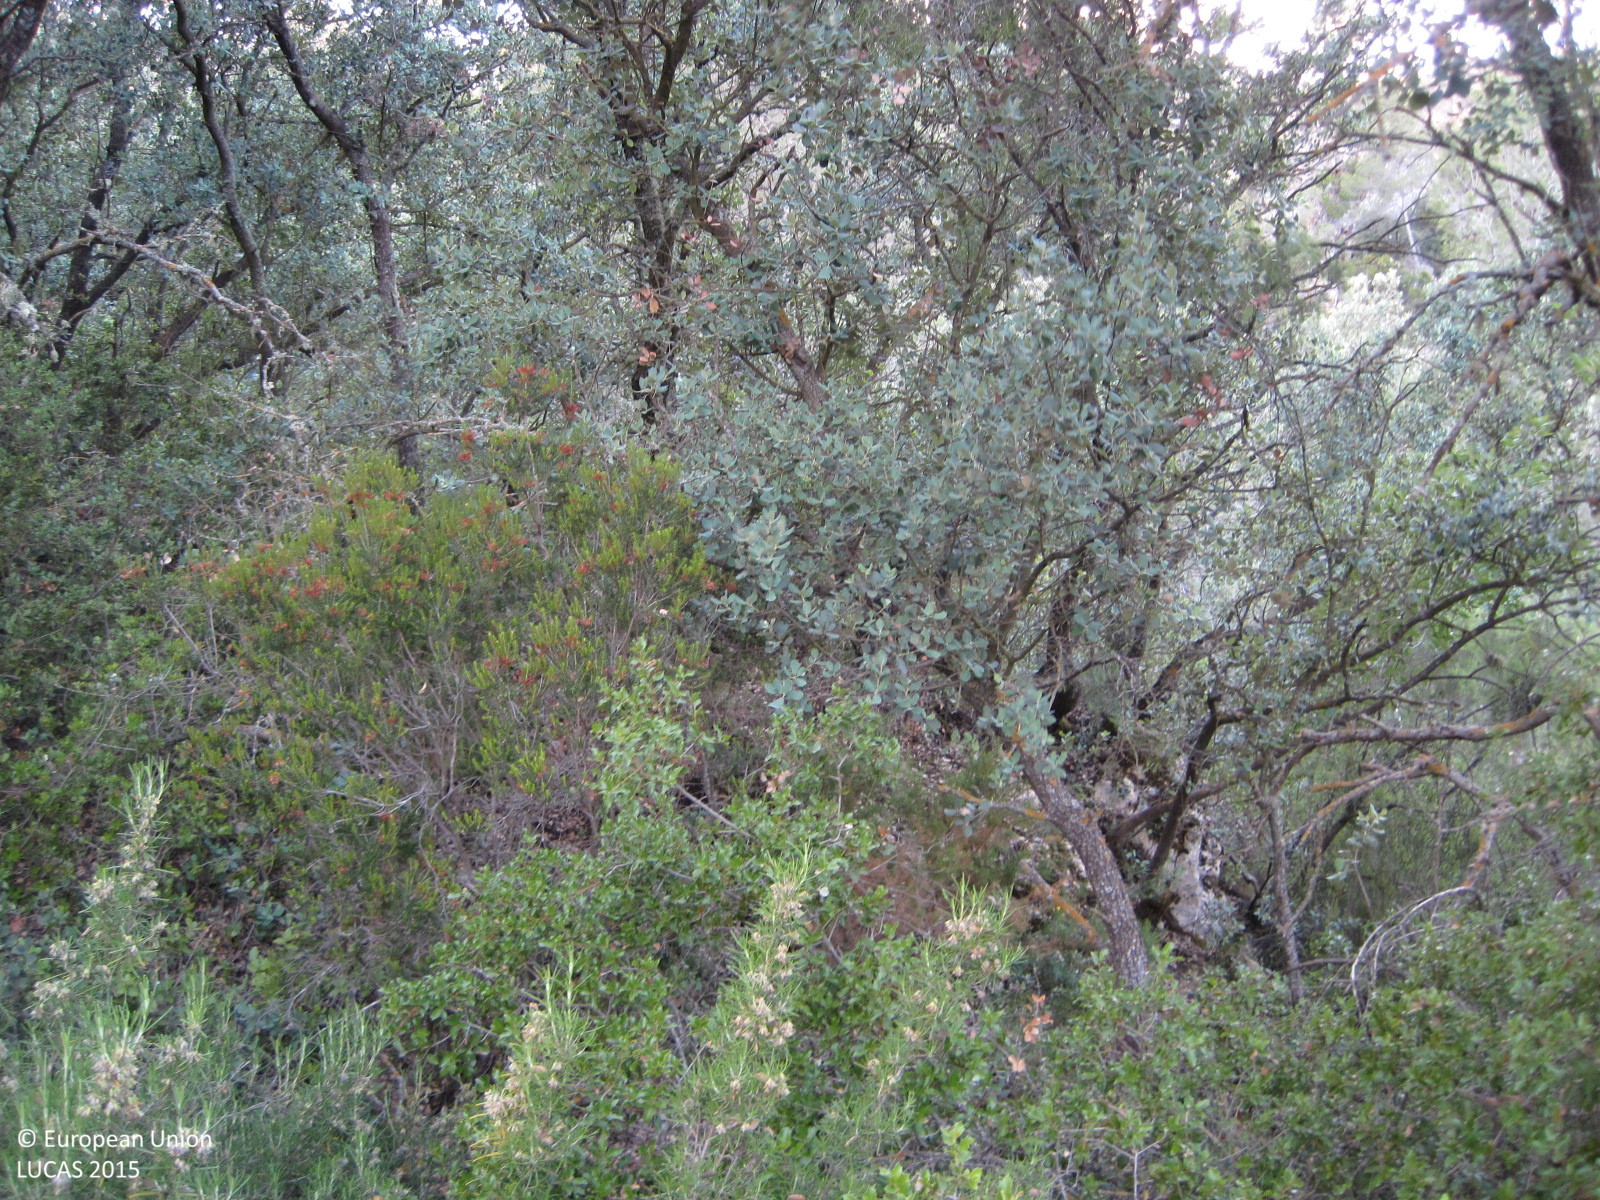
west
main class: Woodland
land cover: Broadleaved woodland
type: broadleaved evergreen forest
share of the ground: 50 - 75 %
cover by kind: broadleaved forest trees 50 %, shrubs 25 %, coniferous forest trees 15 %, herbaceous plants 10 %
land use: Forestry
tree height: > 5 m
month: May
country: ES
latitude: 39.4378
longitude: -1.0731
